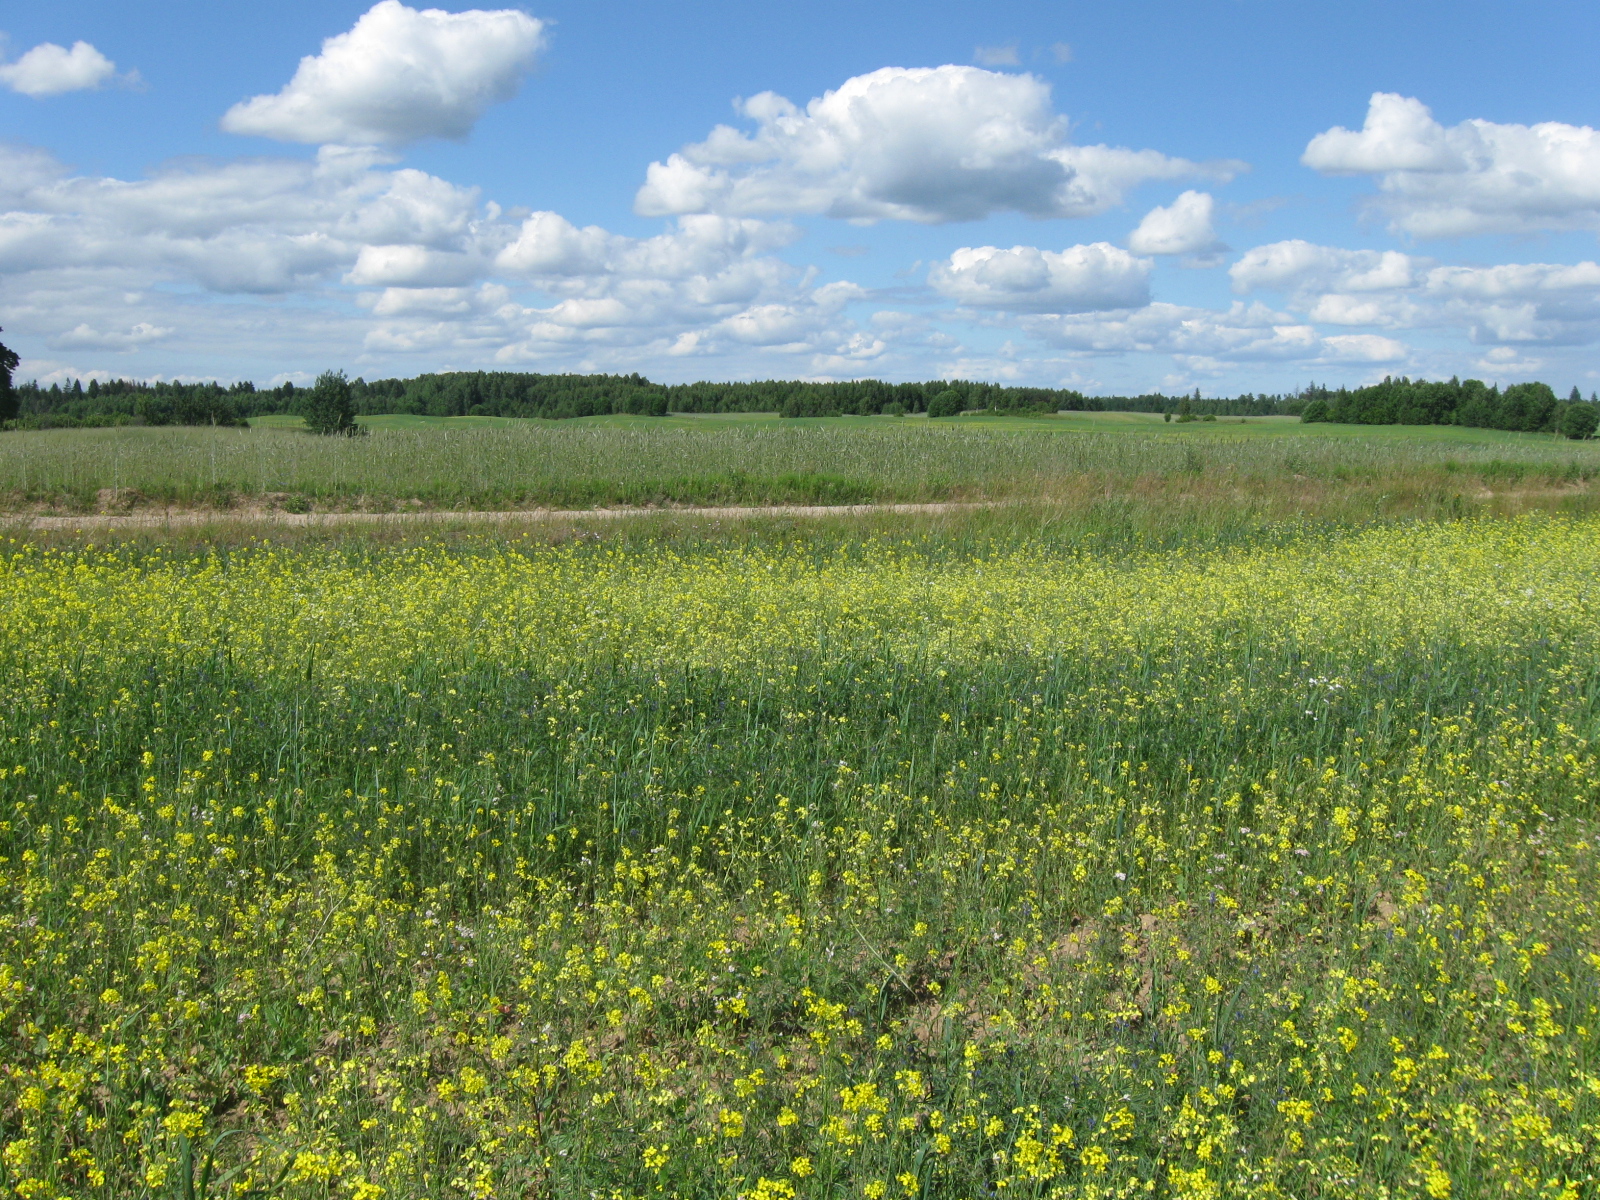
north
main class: Cropland
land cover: Dry pulses
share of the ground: > 75 %
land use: Agriculture (excluding fallow land and kitchen gardens)
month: June
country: LT
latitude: 54.5211
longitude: 24.6125
